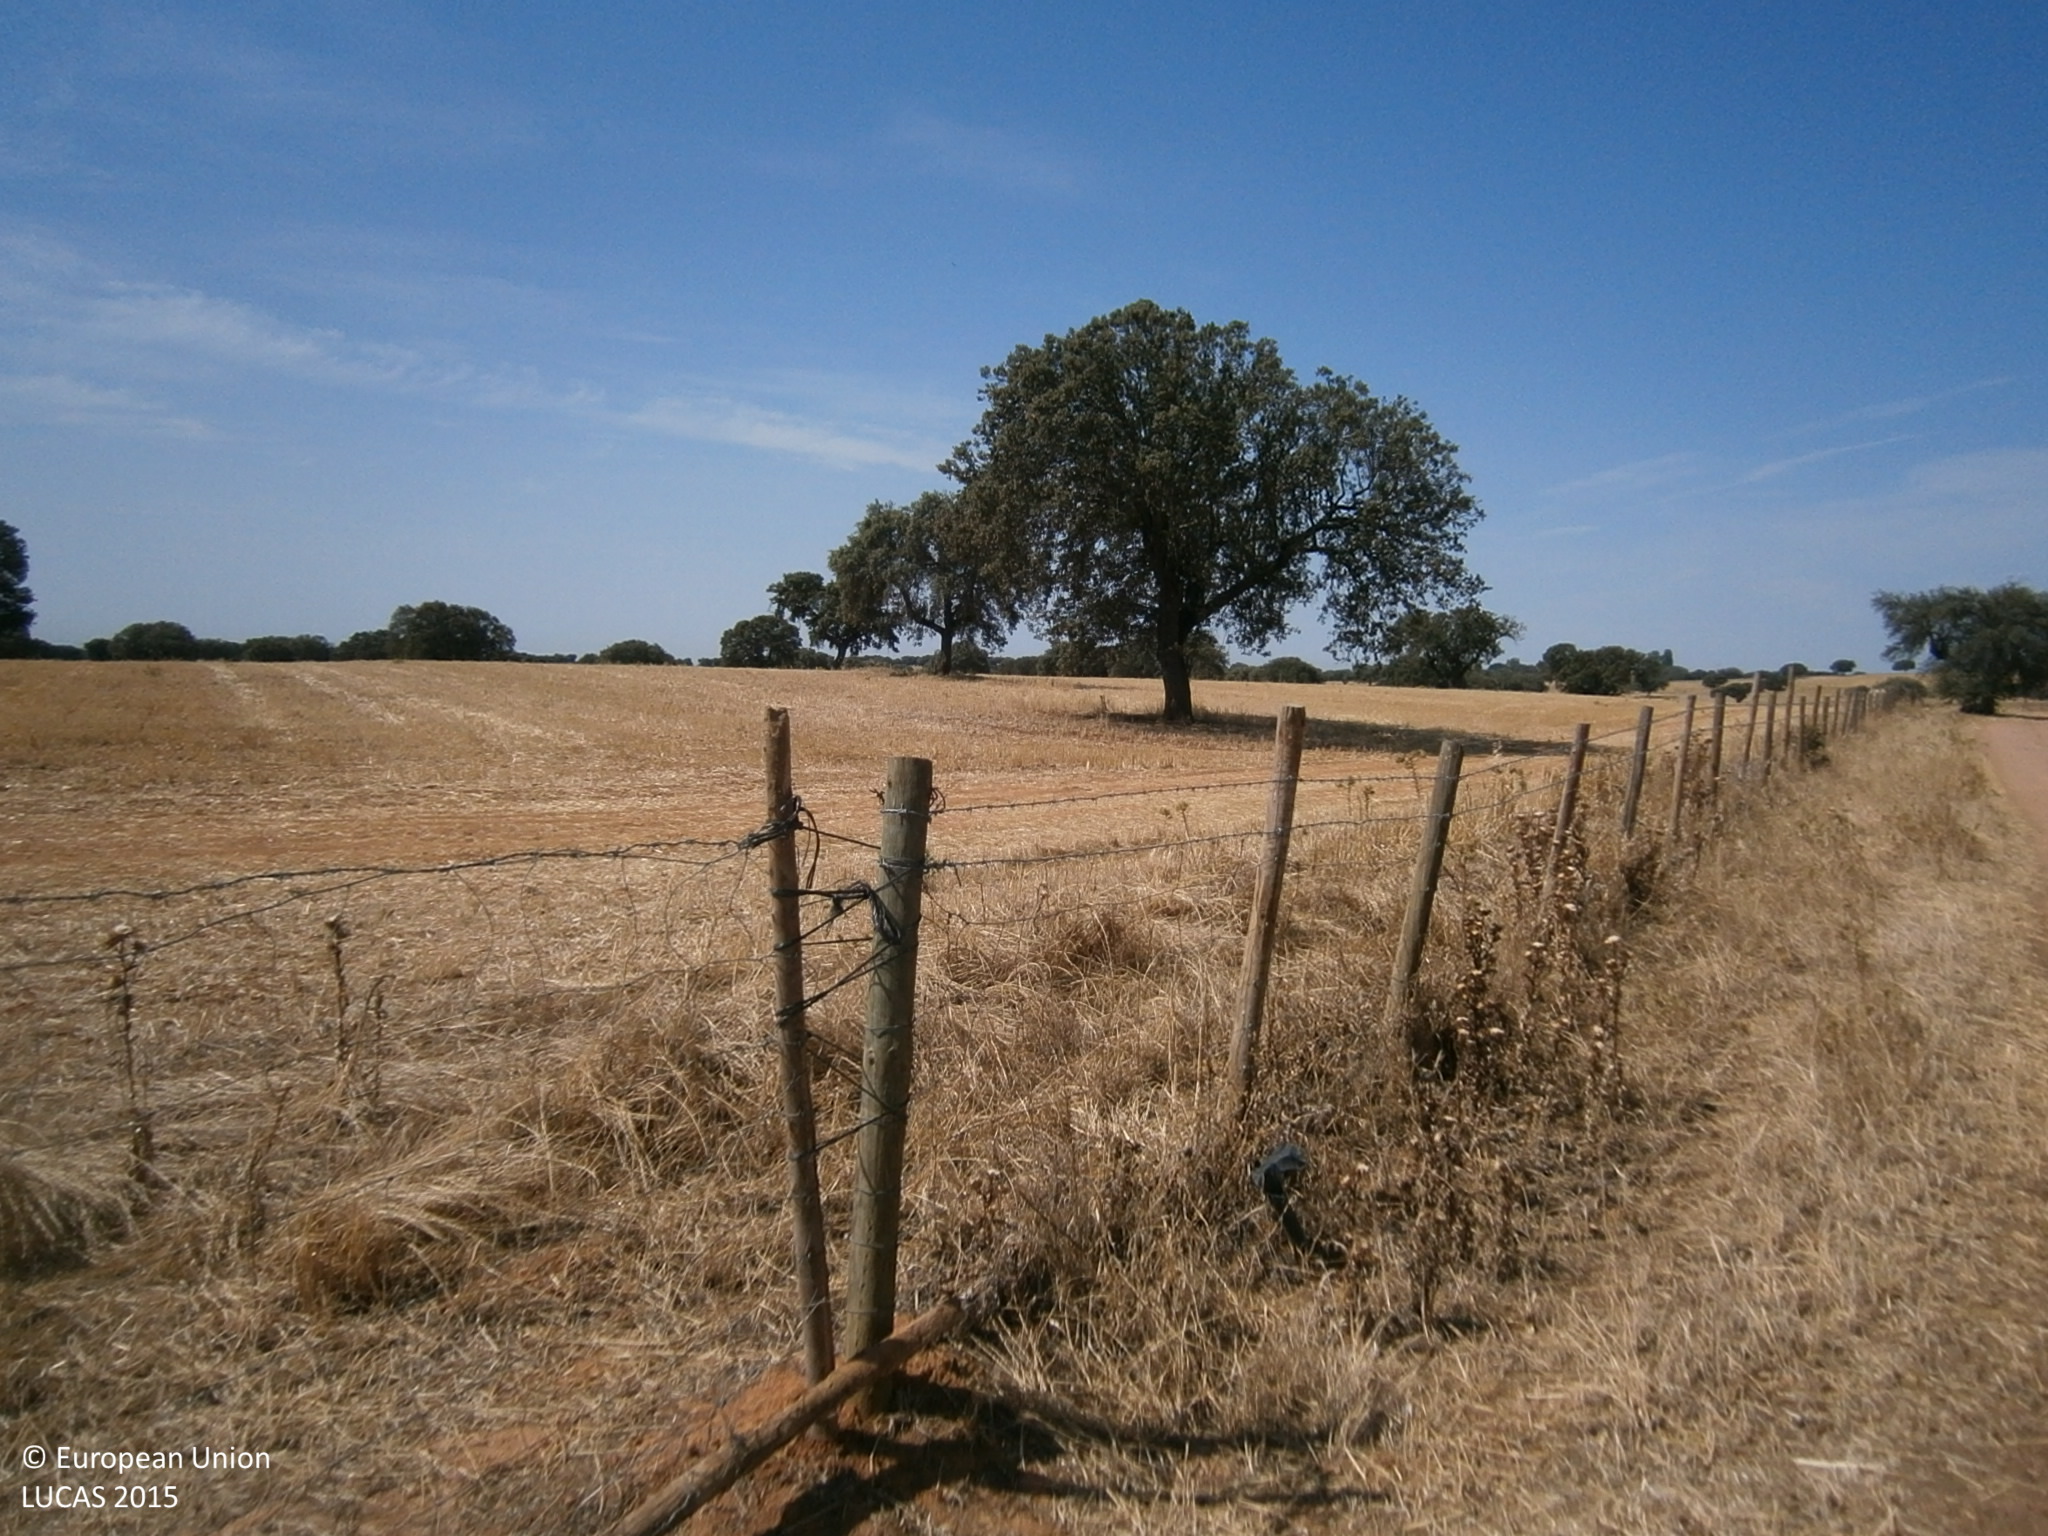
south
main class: Cropland
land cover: Durum wheat
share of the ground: > 75 %
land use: Agriculture (excluding fallow land and kitchen gardens)
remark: Harvested field
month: July
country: ES
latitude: 39.0094
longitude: -6.8020
